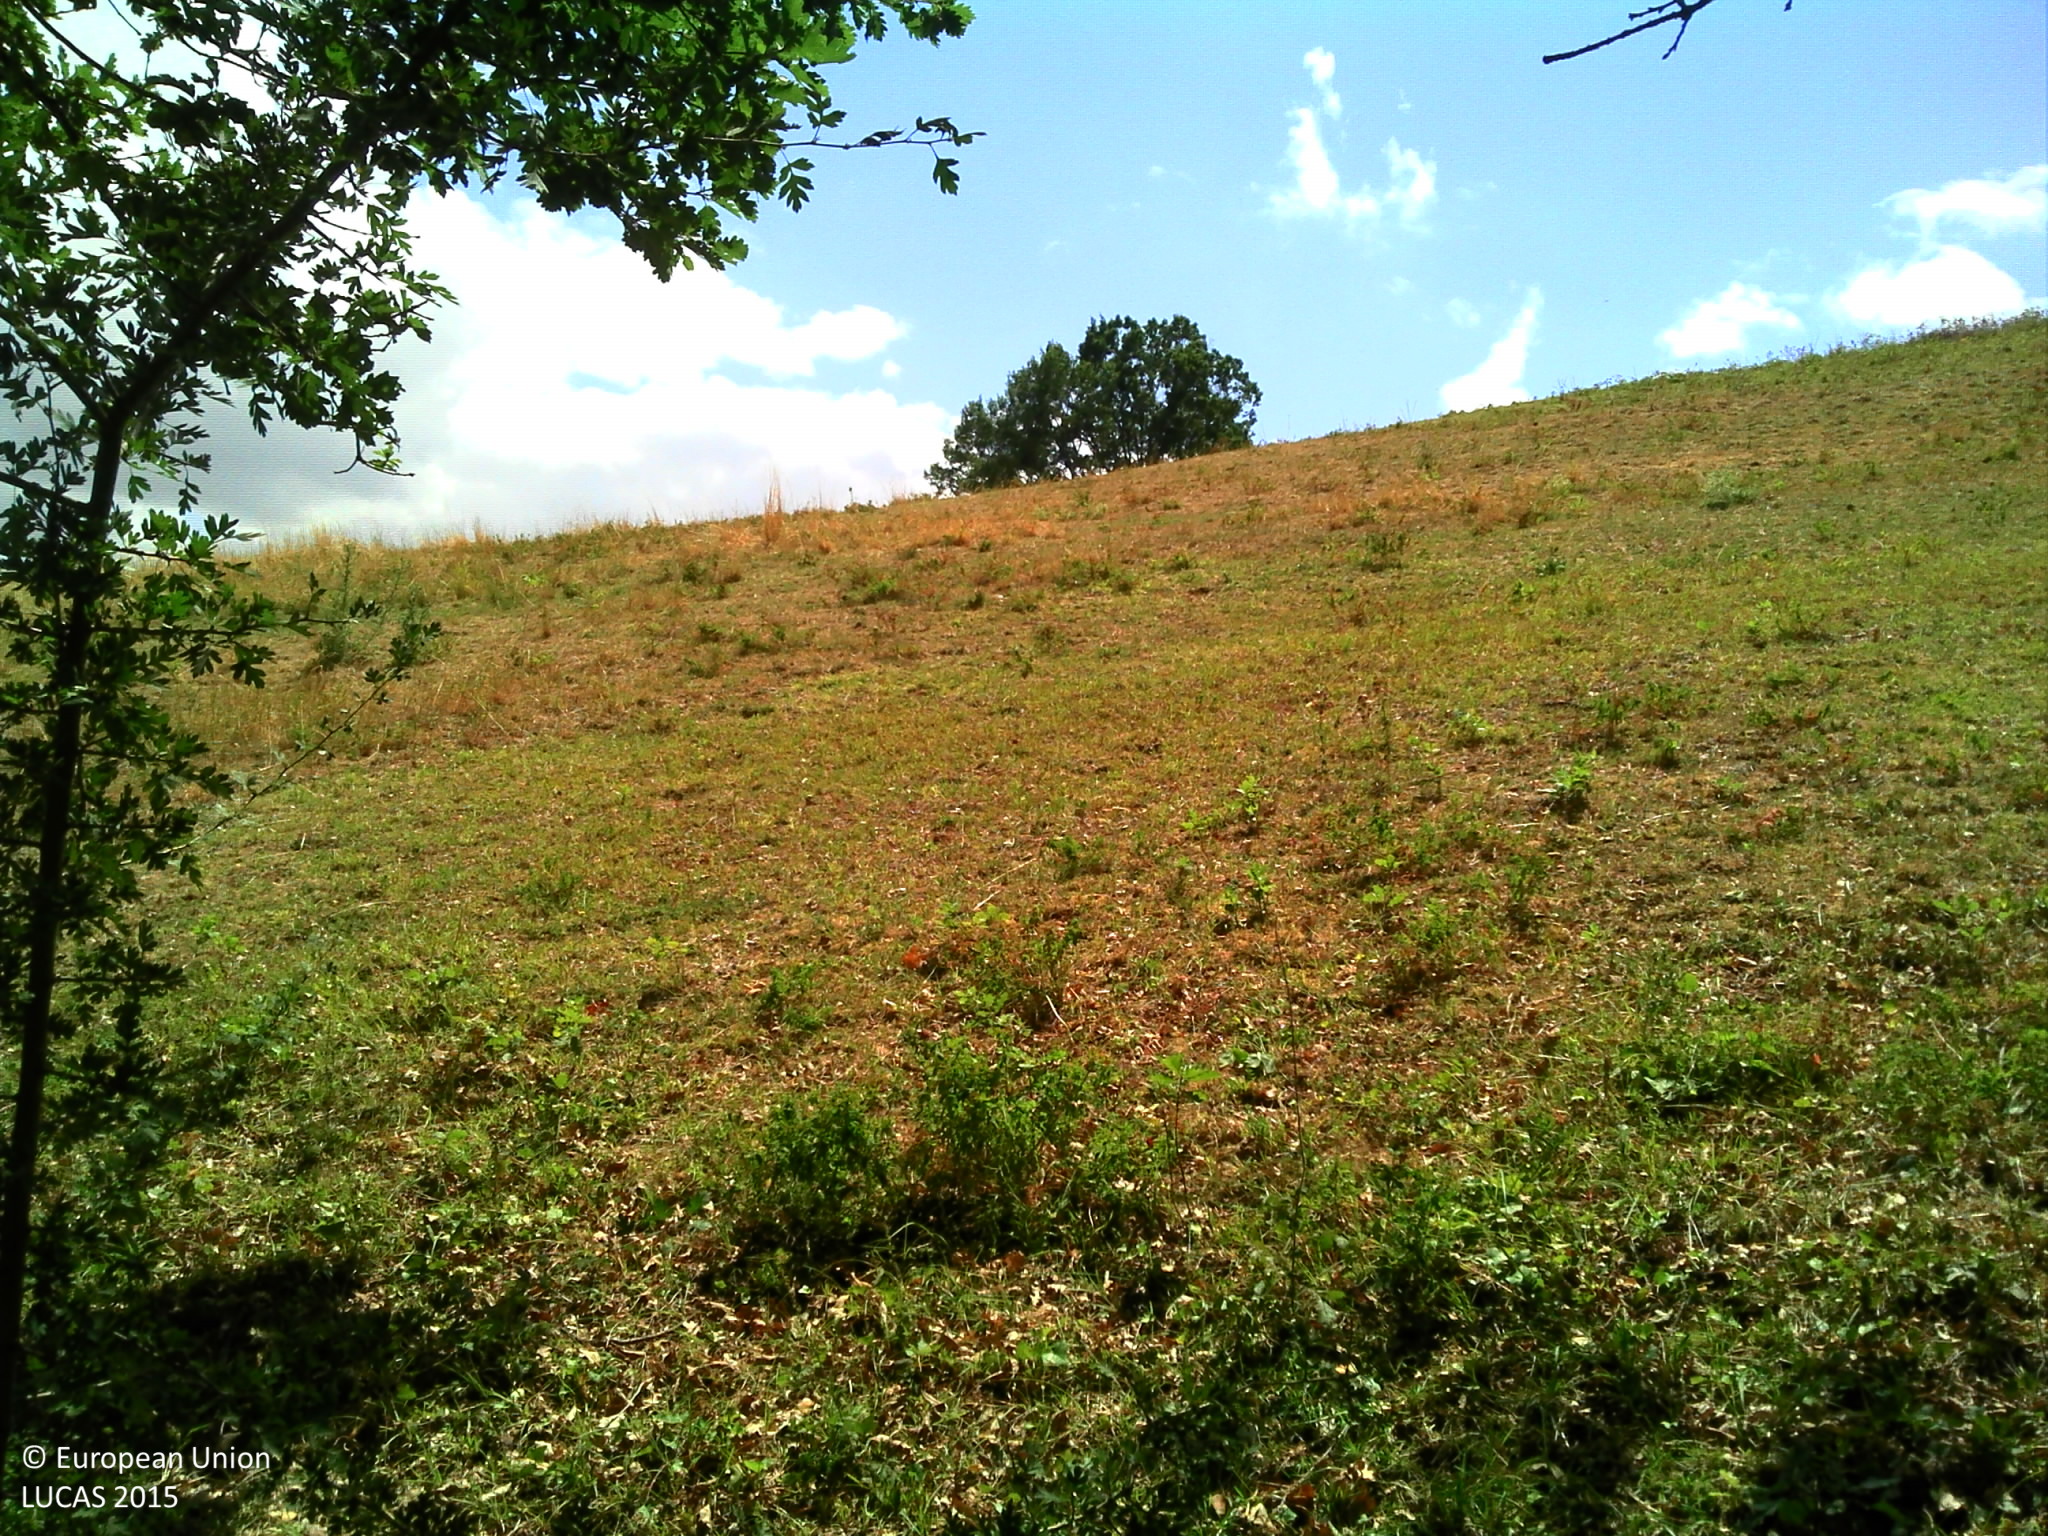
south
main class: Woodland
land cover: Broadleaved woodland
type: thermophilous deciduous forest
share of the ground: > 75 %
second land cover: Grassland without tree/shrub cover
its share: > 75 %
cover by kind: broadleaved forest trees 65 %, herbaceous plants 35 %
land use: Forestry
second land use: Agriculture (excluding fallow land and kitchen gardens)
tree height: > 5 m
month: July
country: FR
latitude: 44.3738
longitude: 0.5684
